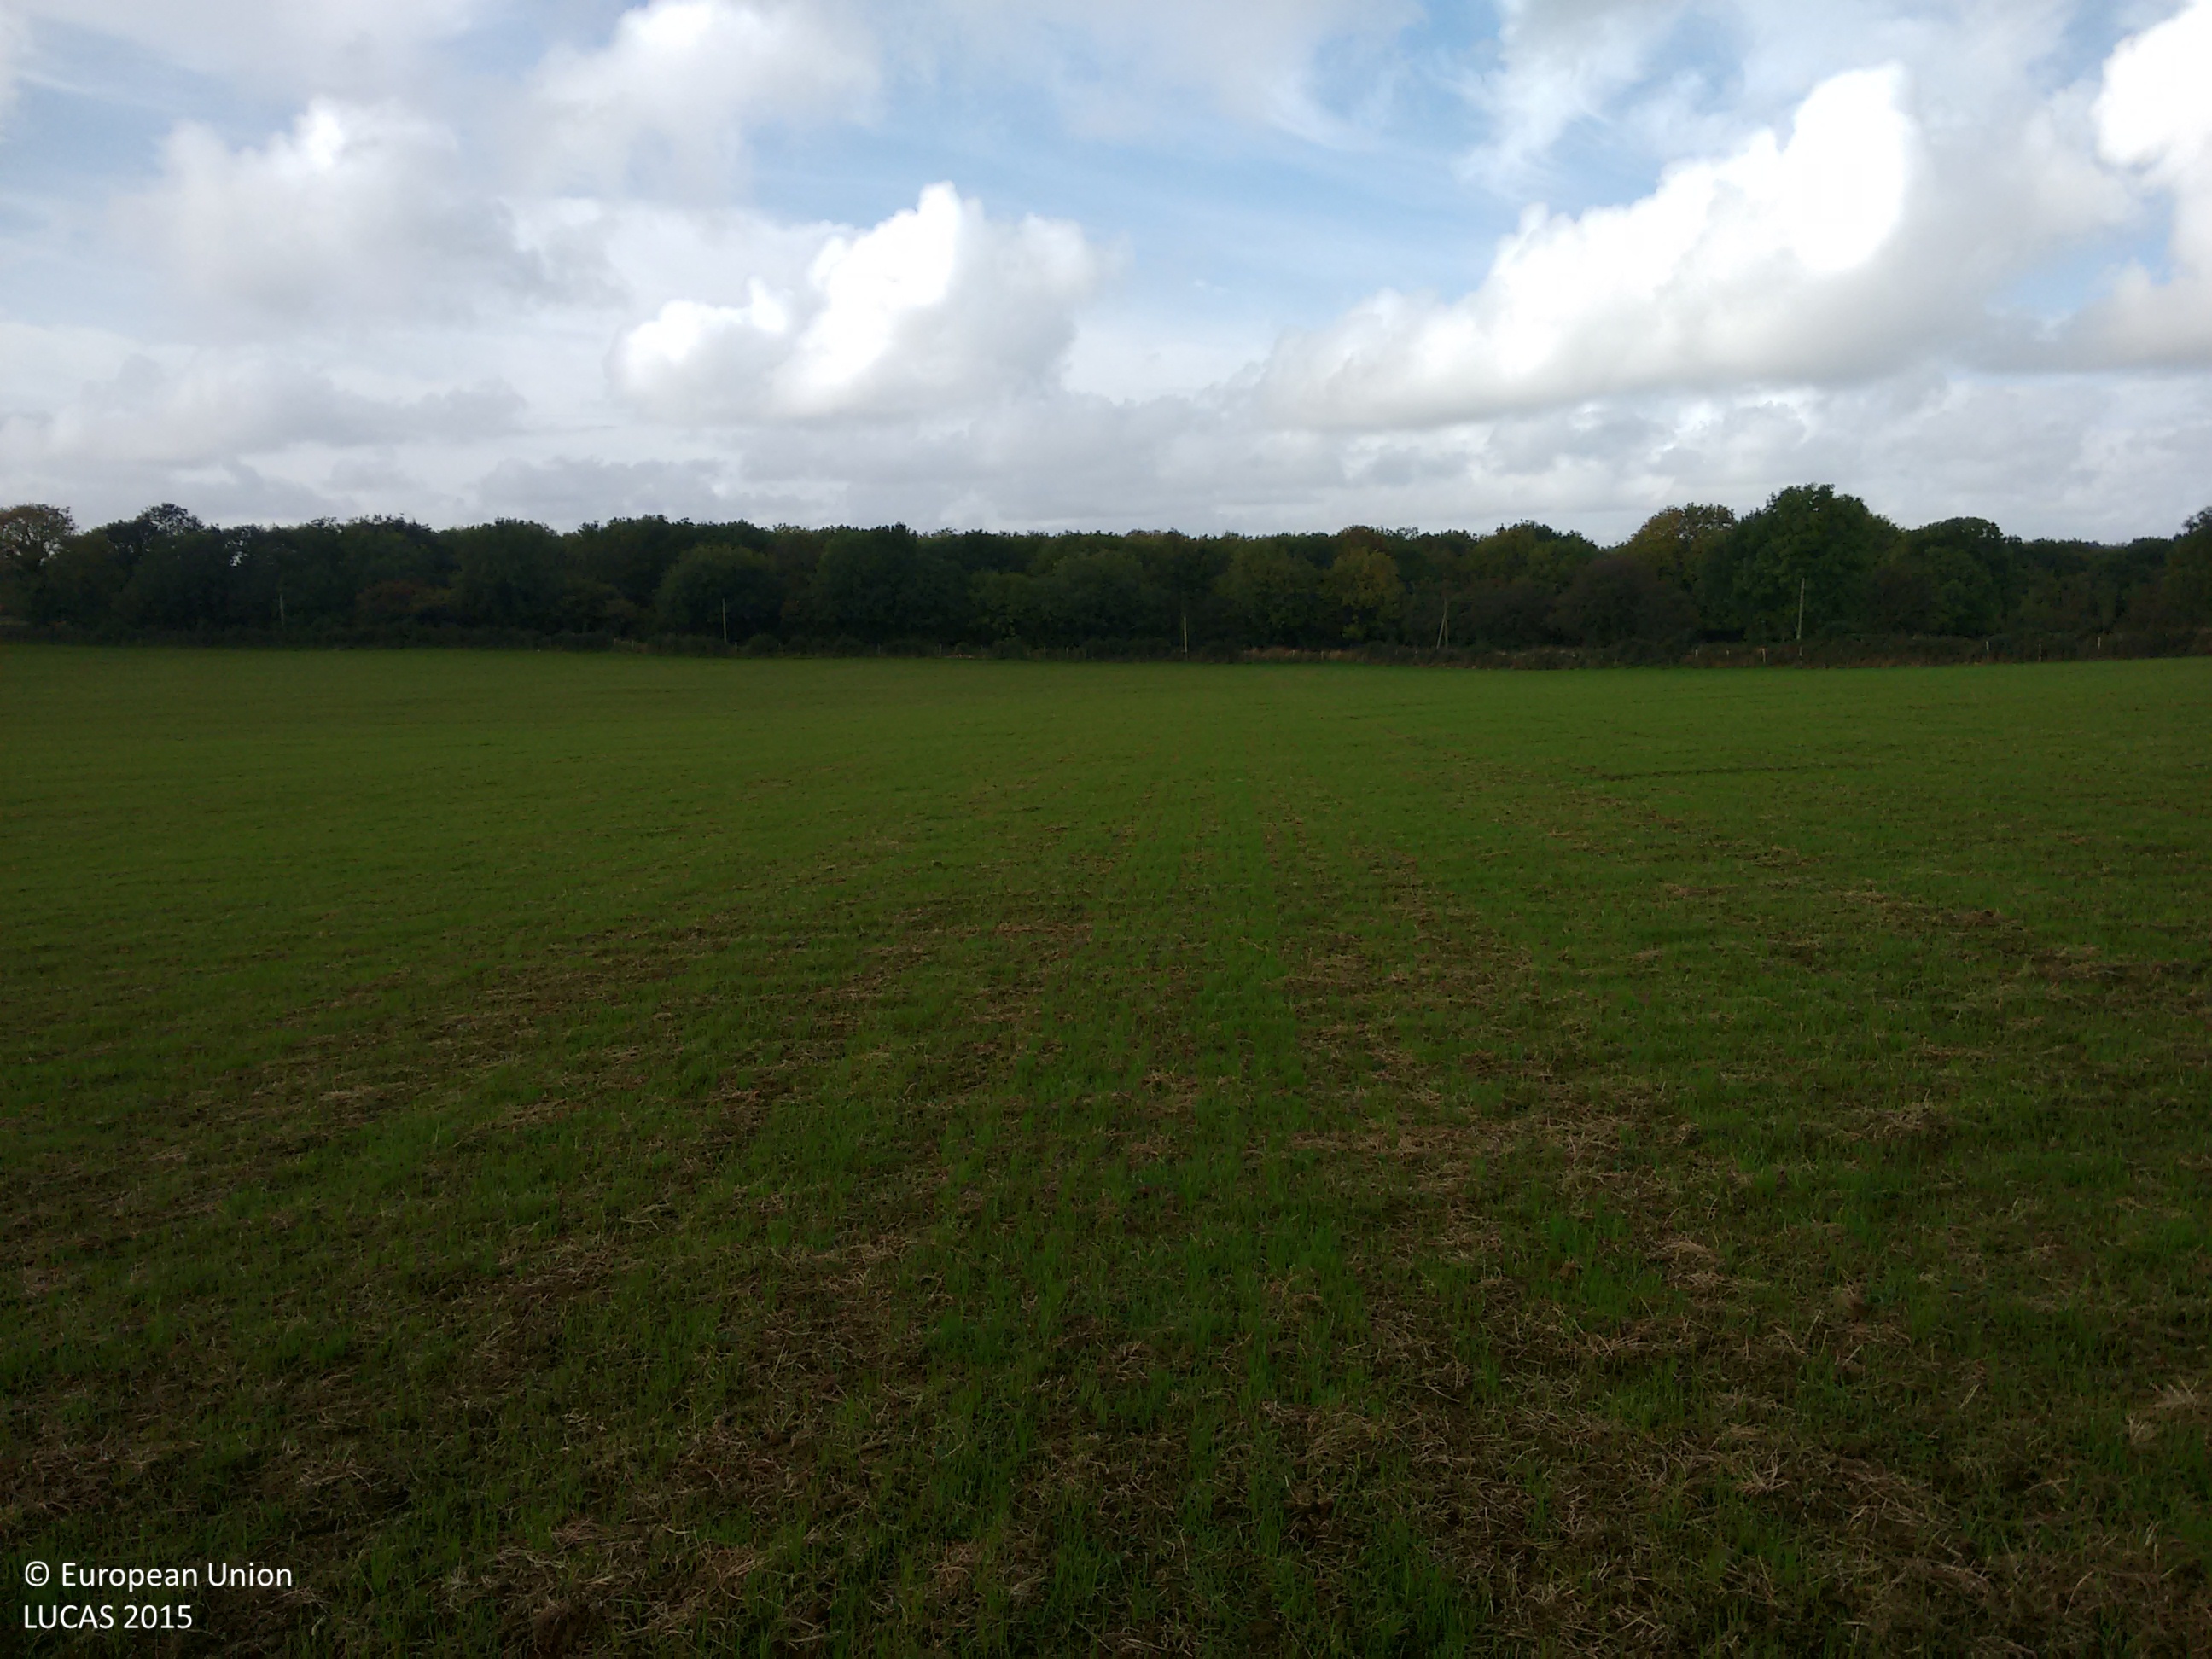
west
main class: Grassland
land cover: Grassland without tree/shrub cover
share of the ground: > 75 %
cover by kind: herbaceous plants 85 %, unconsolidated bare surface 10 %
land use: Agriculture (excluding fallow land and kitchen gardens)
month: October
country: IE
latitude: 53.7794
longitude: -8.0690
